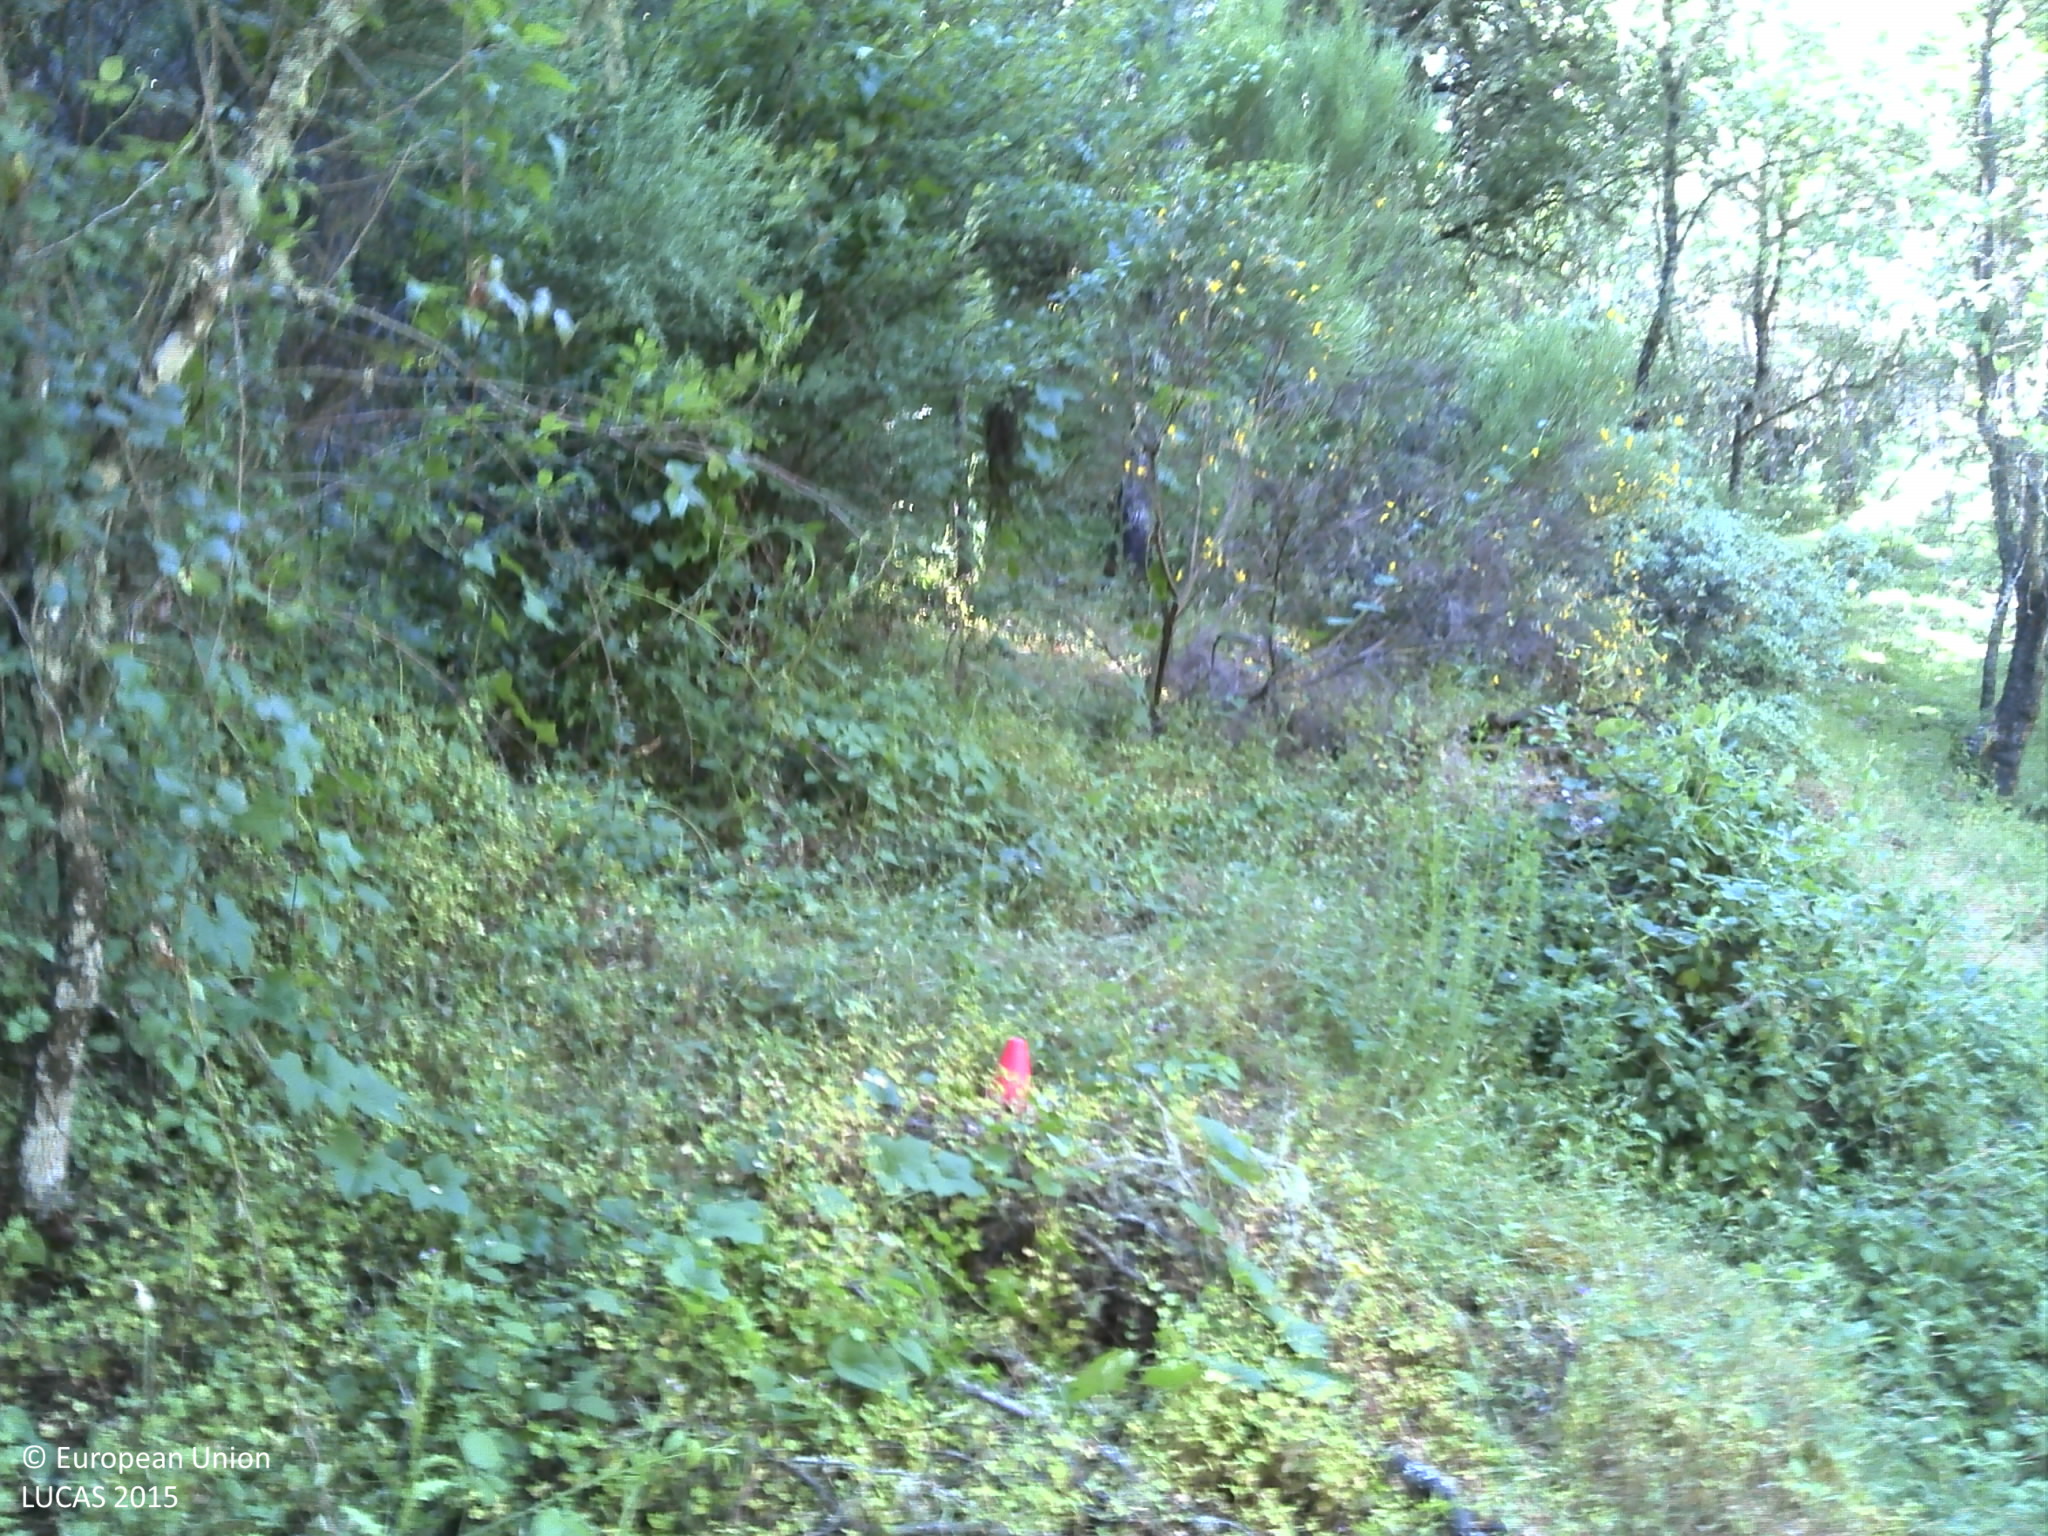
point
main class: Woodland
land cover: Broadleaved woodland
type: thermophilous deciduous forest
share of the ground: > 75 %
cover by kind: shrubs 50 %, broadleaved forest trees 25 %, herbaceous plants 20 %, coniferous forest trees 5 %
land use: Forestry
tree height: > 5 m
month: May
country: PT
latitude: 41.7520
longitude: -6.5965
